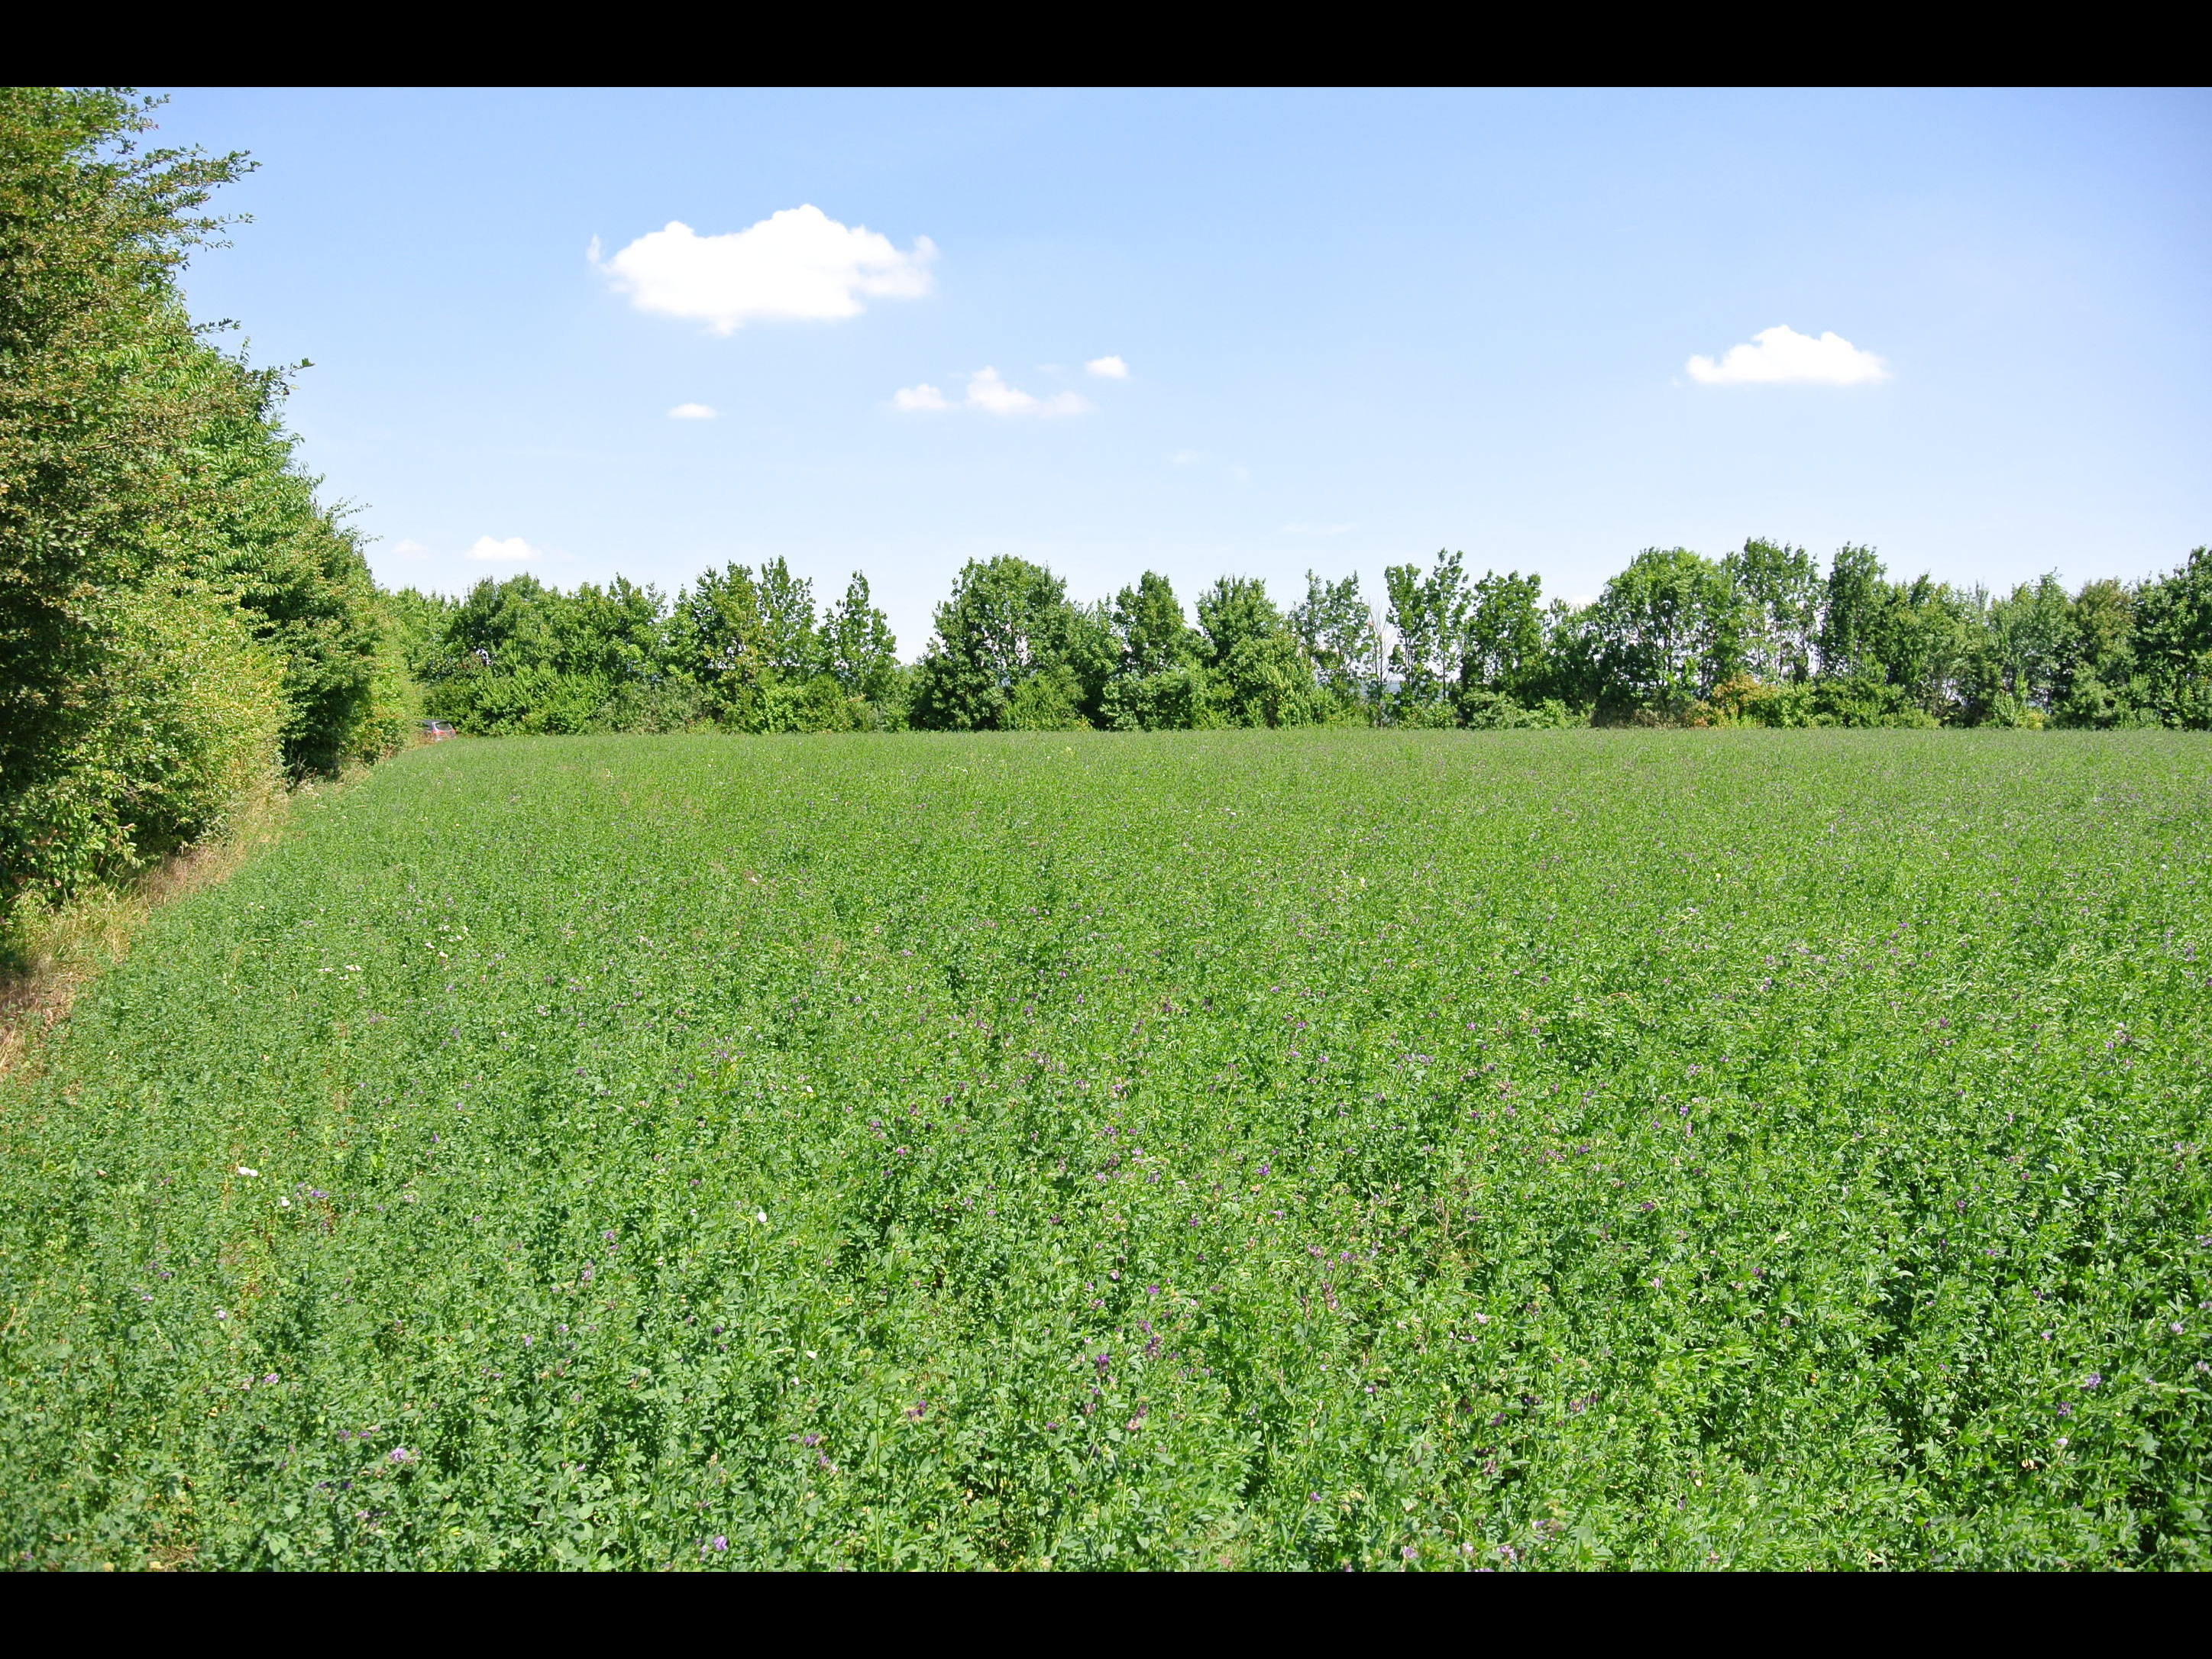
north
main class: Cropland
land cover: Lucerne
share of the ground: > 75 %
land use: Agriculture (excluding fallow land and kitchen gardens)
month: June
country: AT
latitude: 47.7982
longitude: 16.4796
